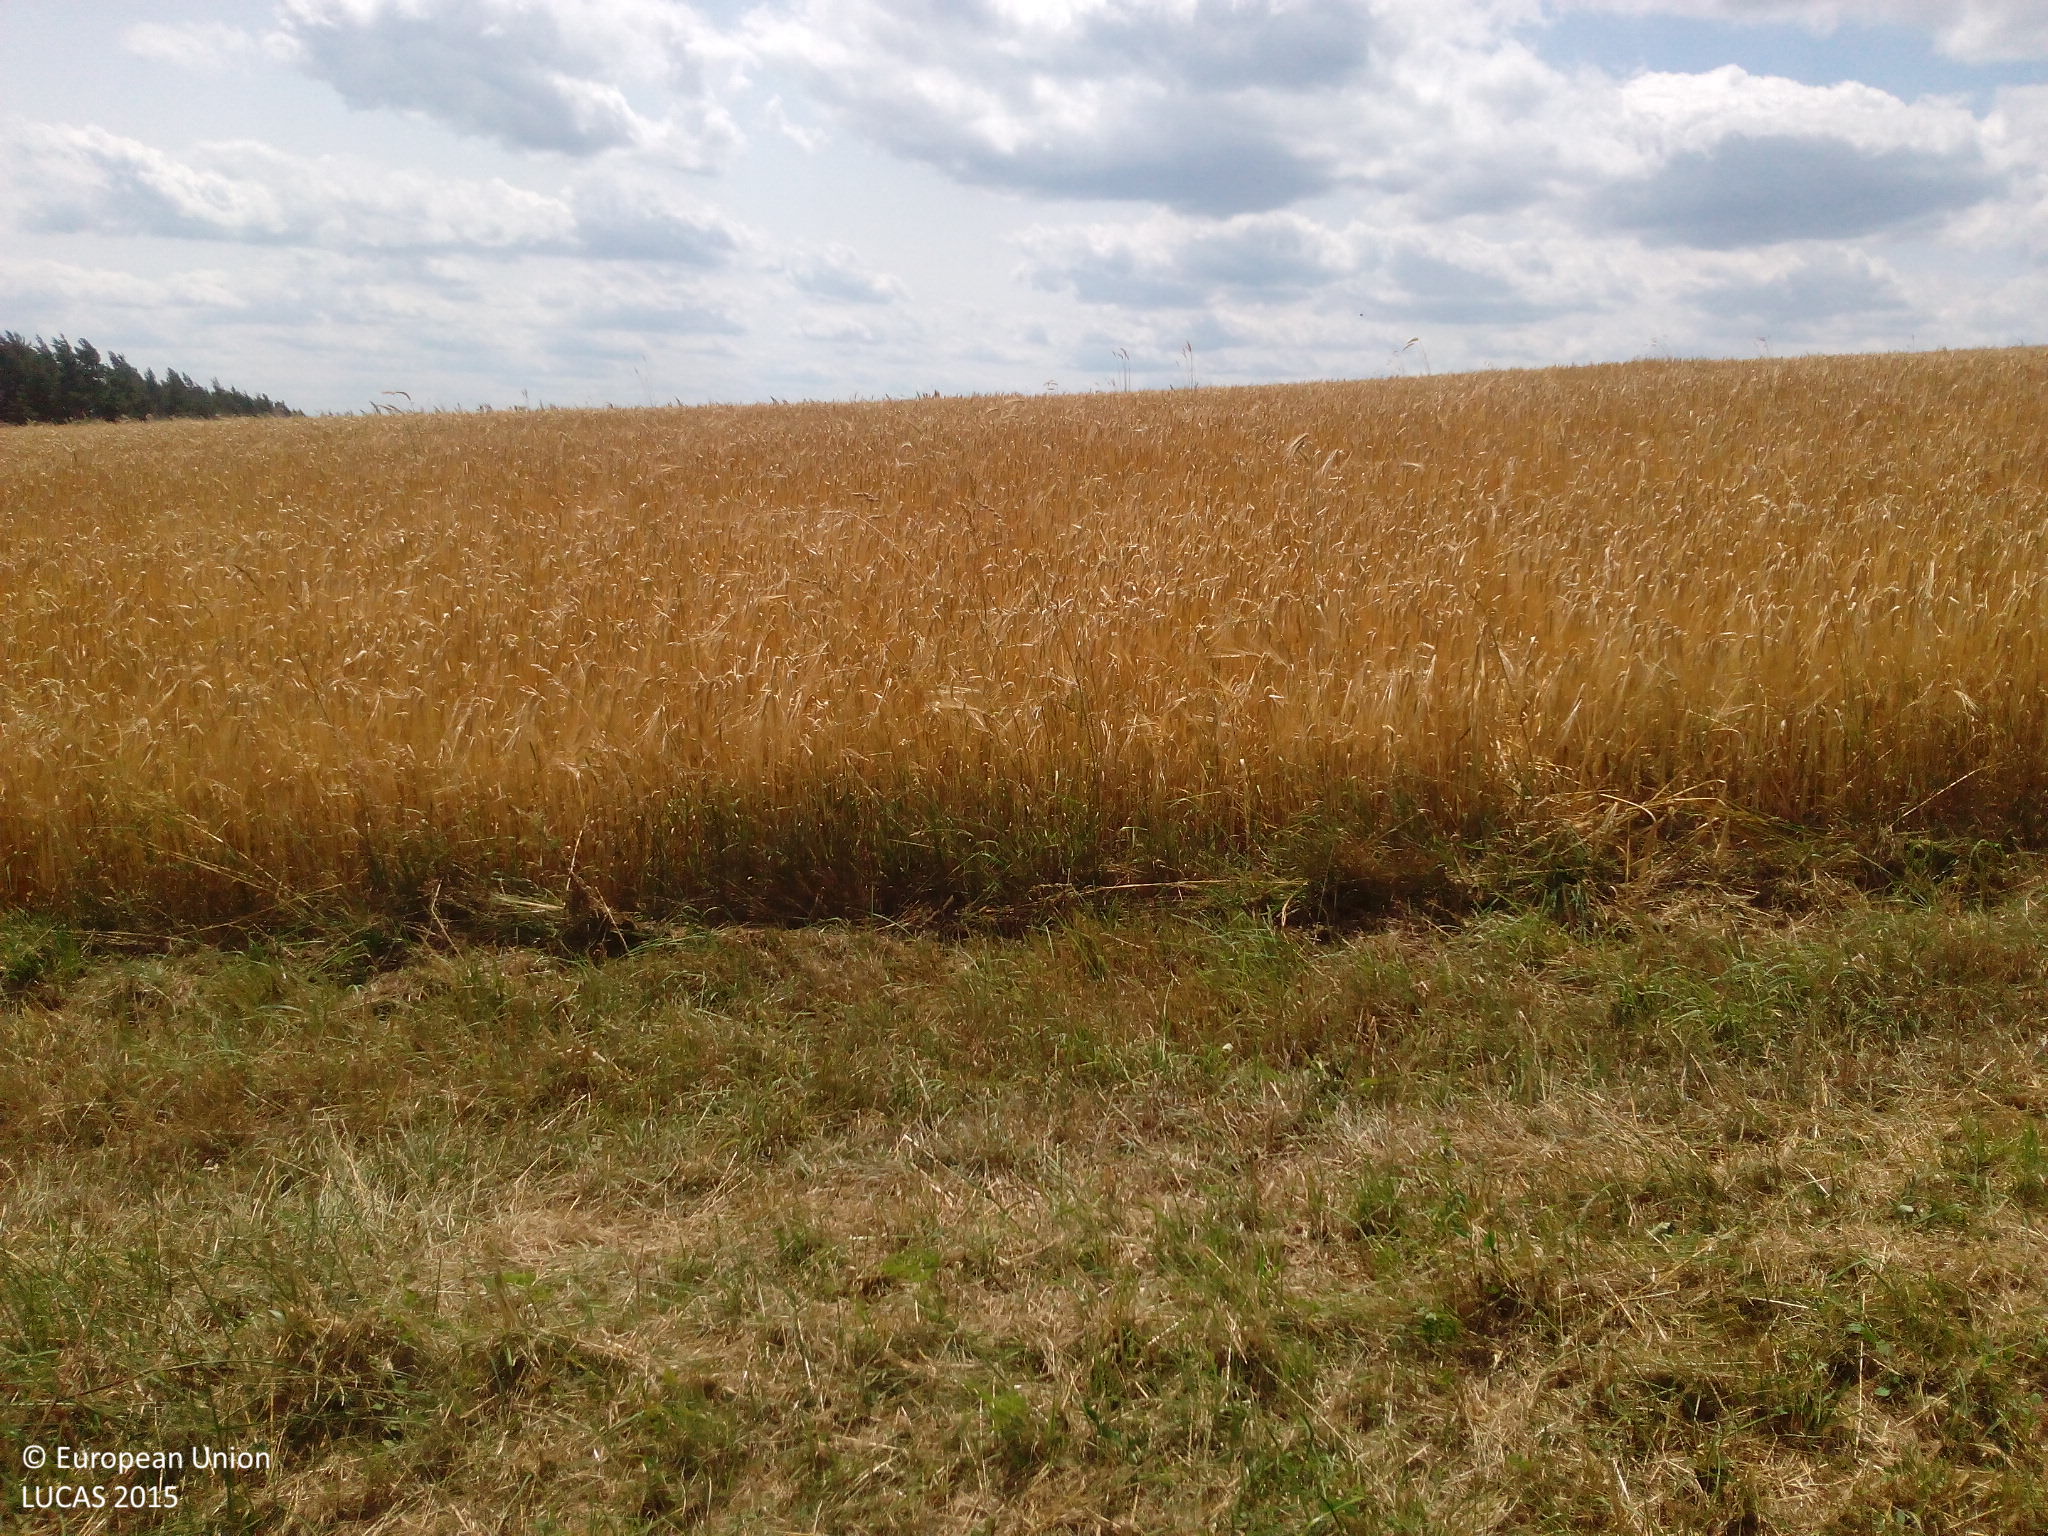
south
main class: Cropland
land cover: Triticale
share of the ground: > 75 %
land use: Agriculture (excluding fallow land and kitchen gardens)
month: July
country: DE
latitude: 49.7872
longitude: 10.5693
